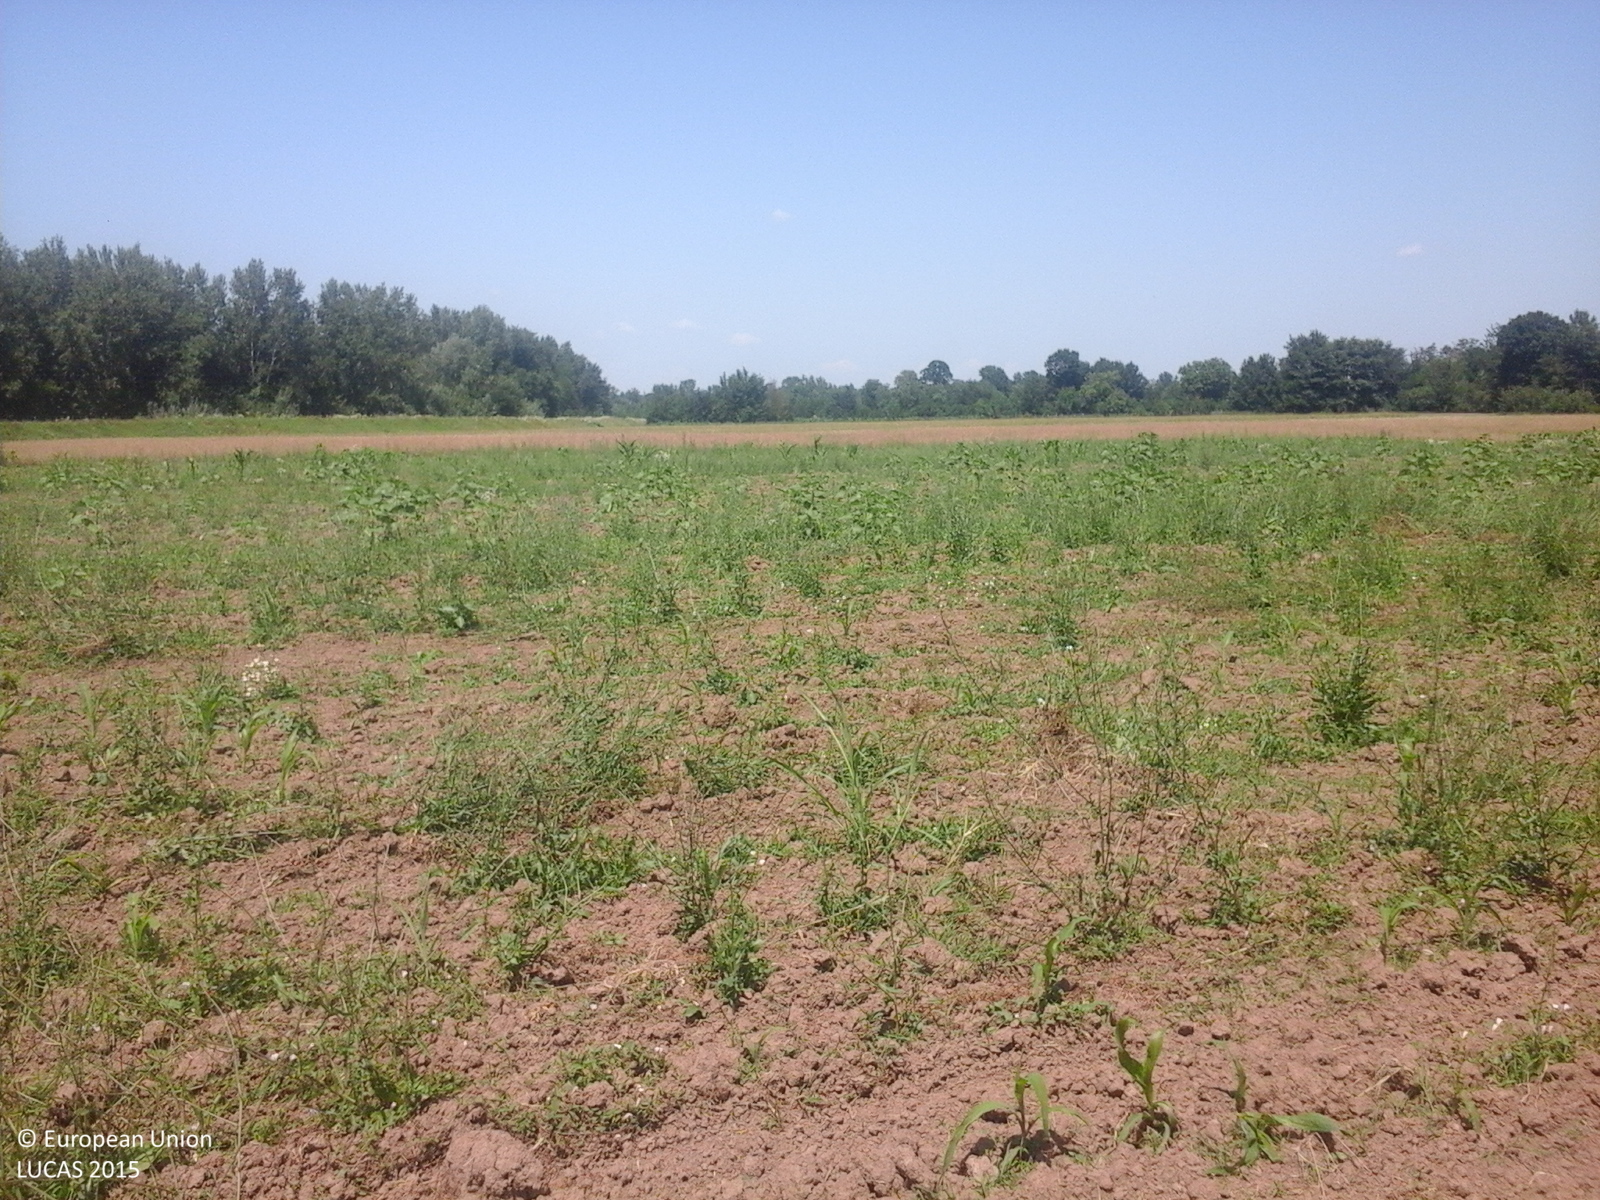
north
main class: Cropland
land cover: Maize
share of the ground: < 10 %
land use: Agriculture (excluding fallow land and kitchen gardens)
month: July
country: RO
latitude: 44.4483
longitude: 24.7140
